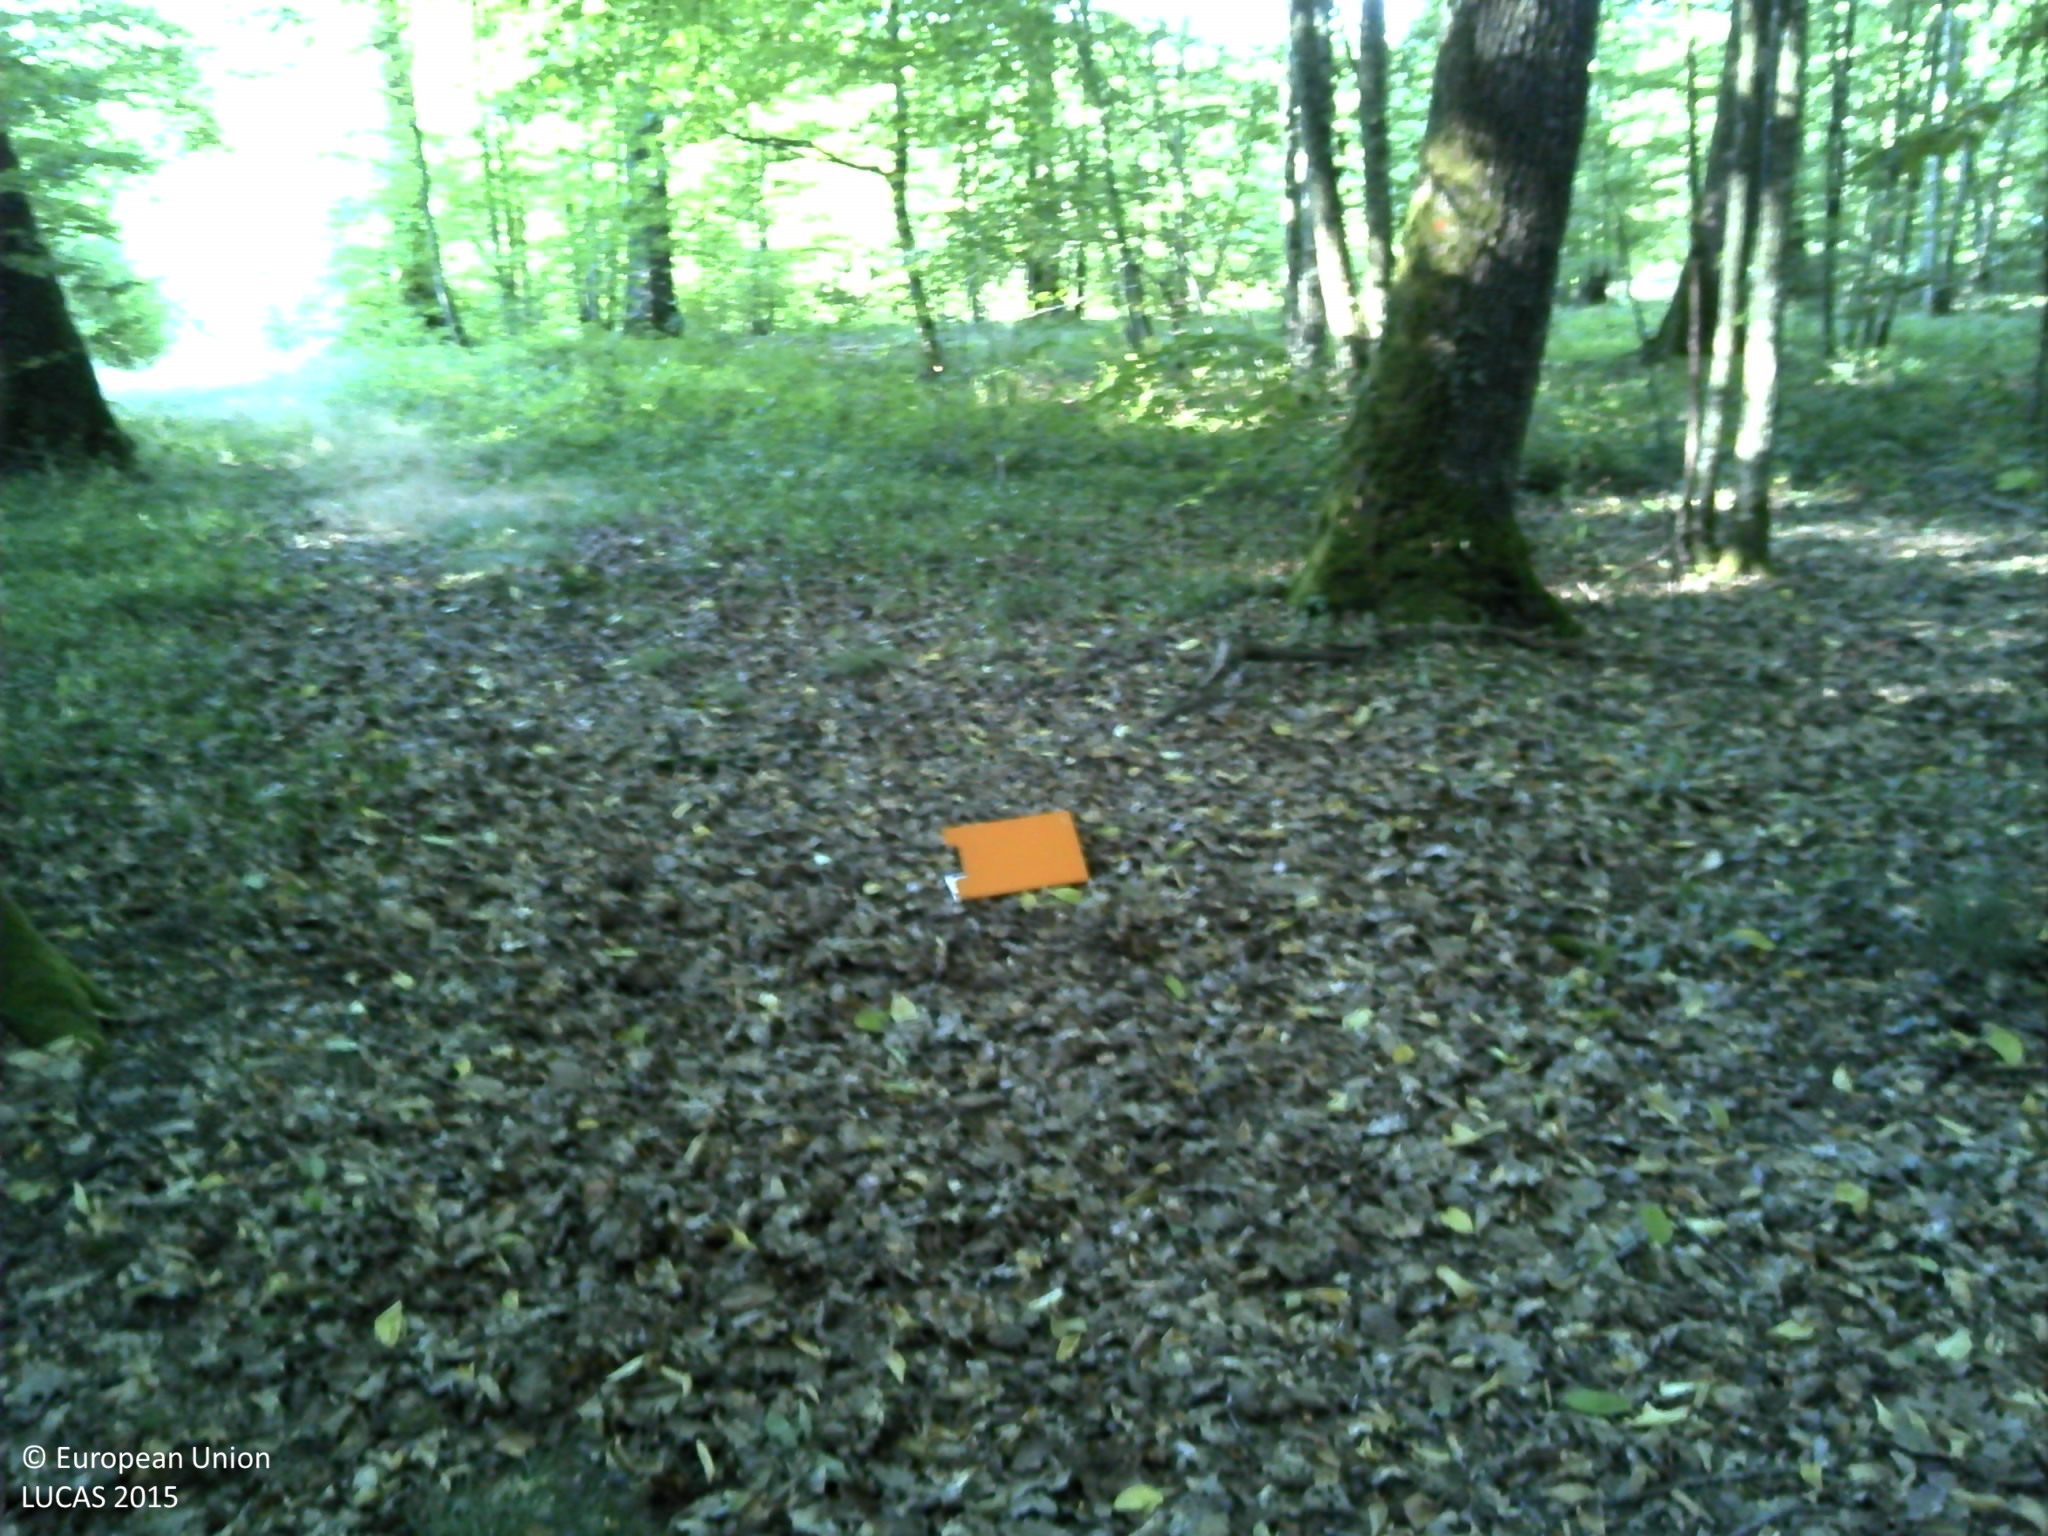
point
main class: Woodland
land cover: Broadleaved woodland
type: mountainous beech forest
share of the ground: > 75 %
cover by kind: broadleaved forest trees 100 %
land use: Forestry
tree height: > 5 m
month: July
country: FR
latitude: 48.2970
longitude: 6.0506
